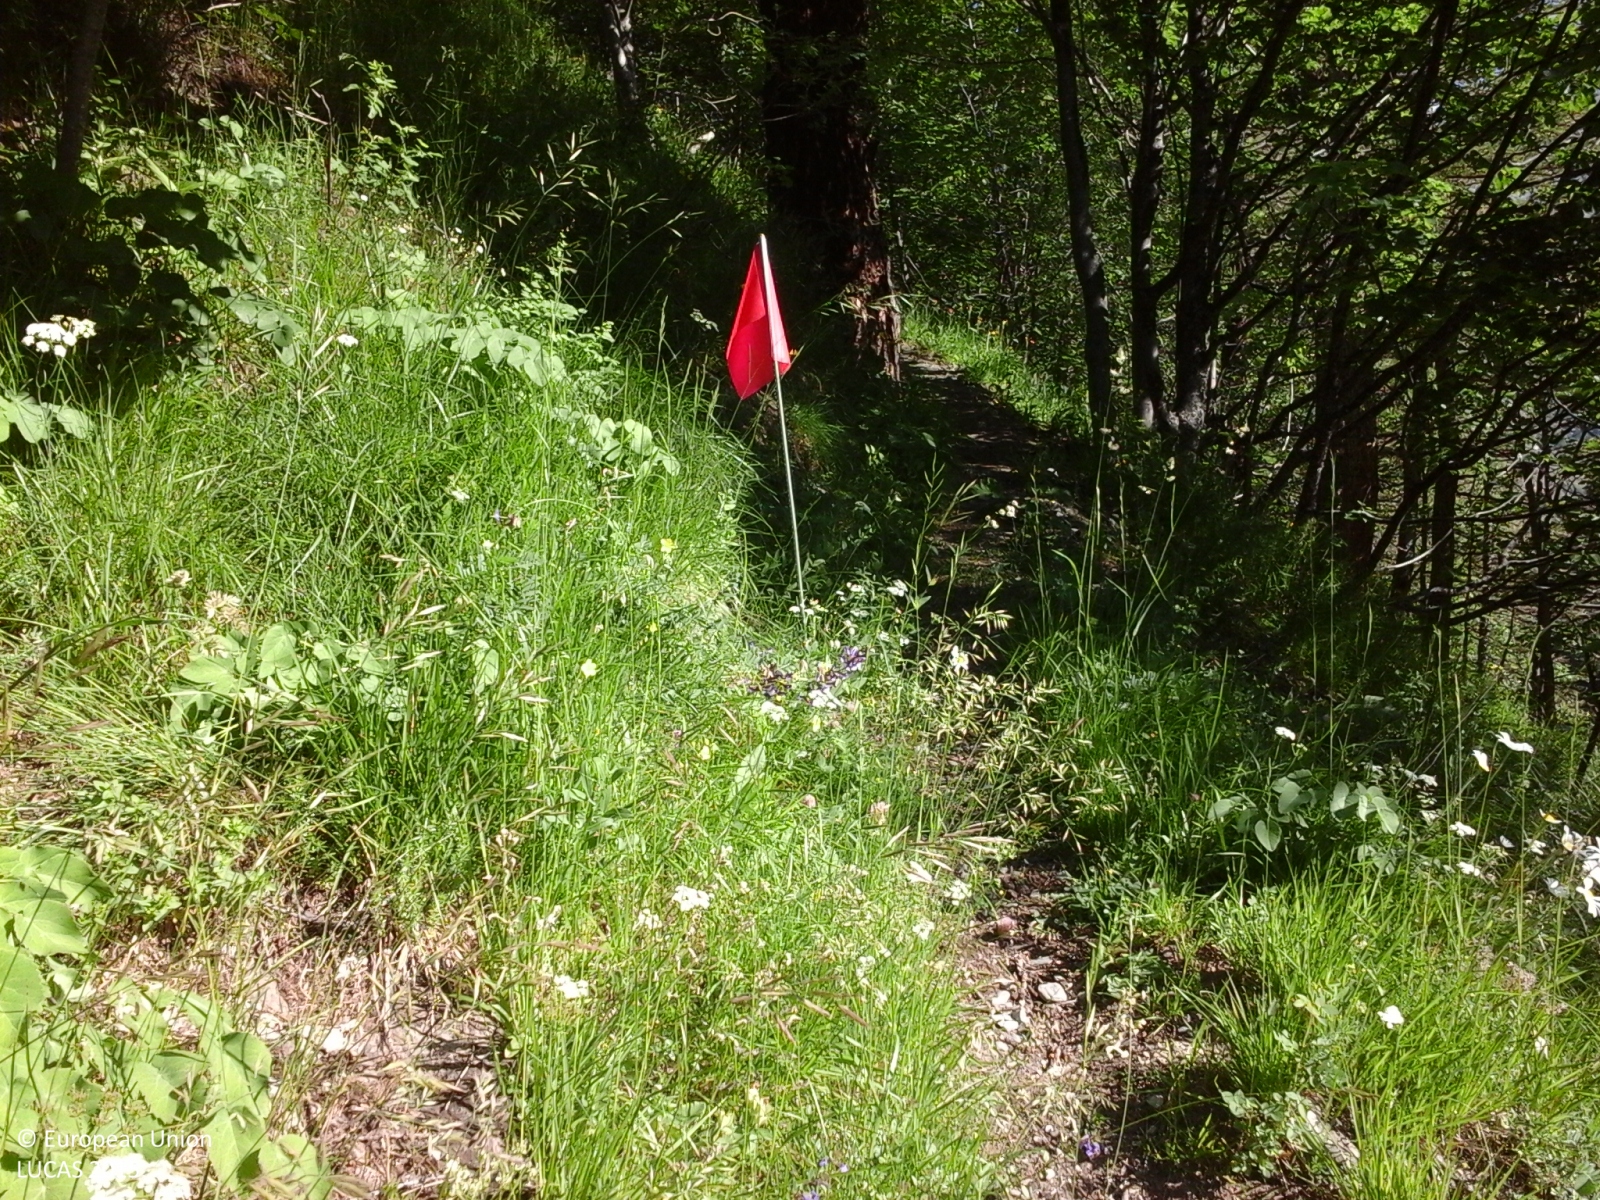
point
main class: Woodland
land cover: Other mixed woodland
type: alpine coniferous forest
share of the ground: > 75 %
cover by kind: coniferous forest trees 45 %, broadleaved forest trees 45 %, herbaceous plants 10 %
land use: Semi-natural and natural areas not in use
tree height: > 5 m
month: June
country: IT
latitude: 45.1097
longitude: 6.6878
